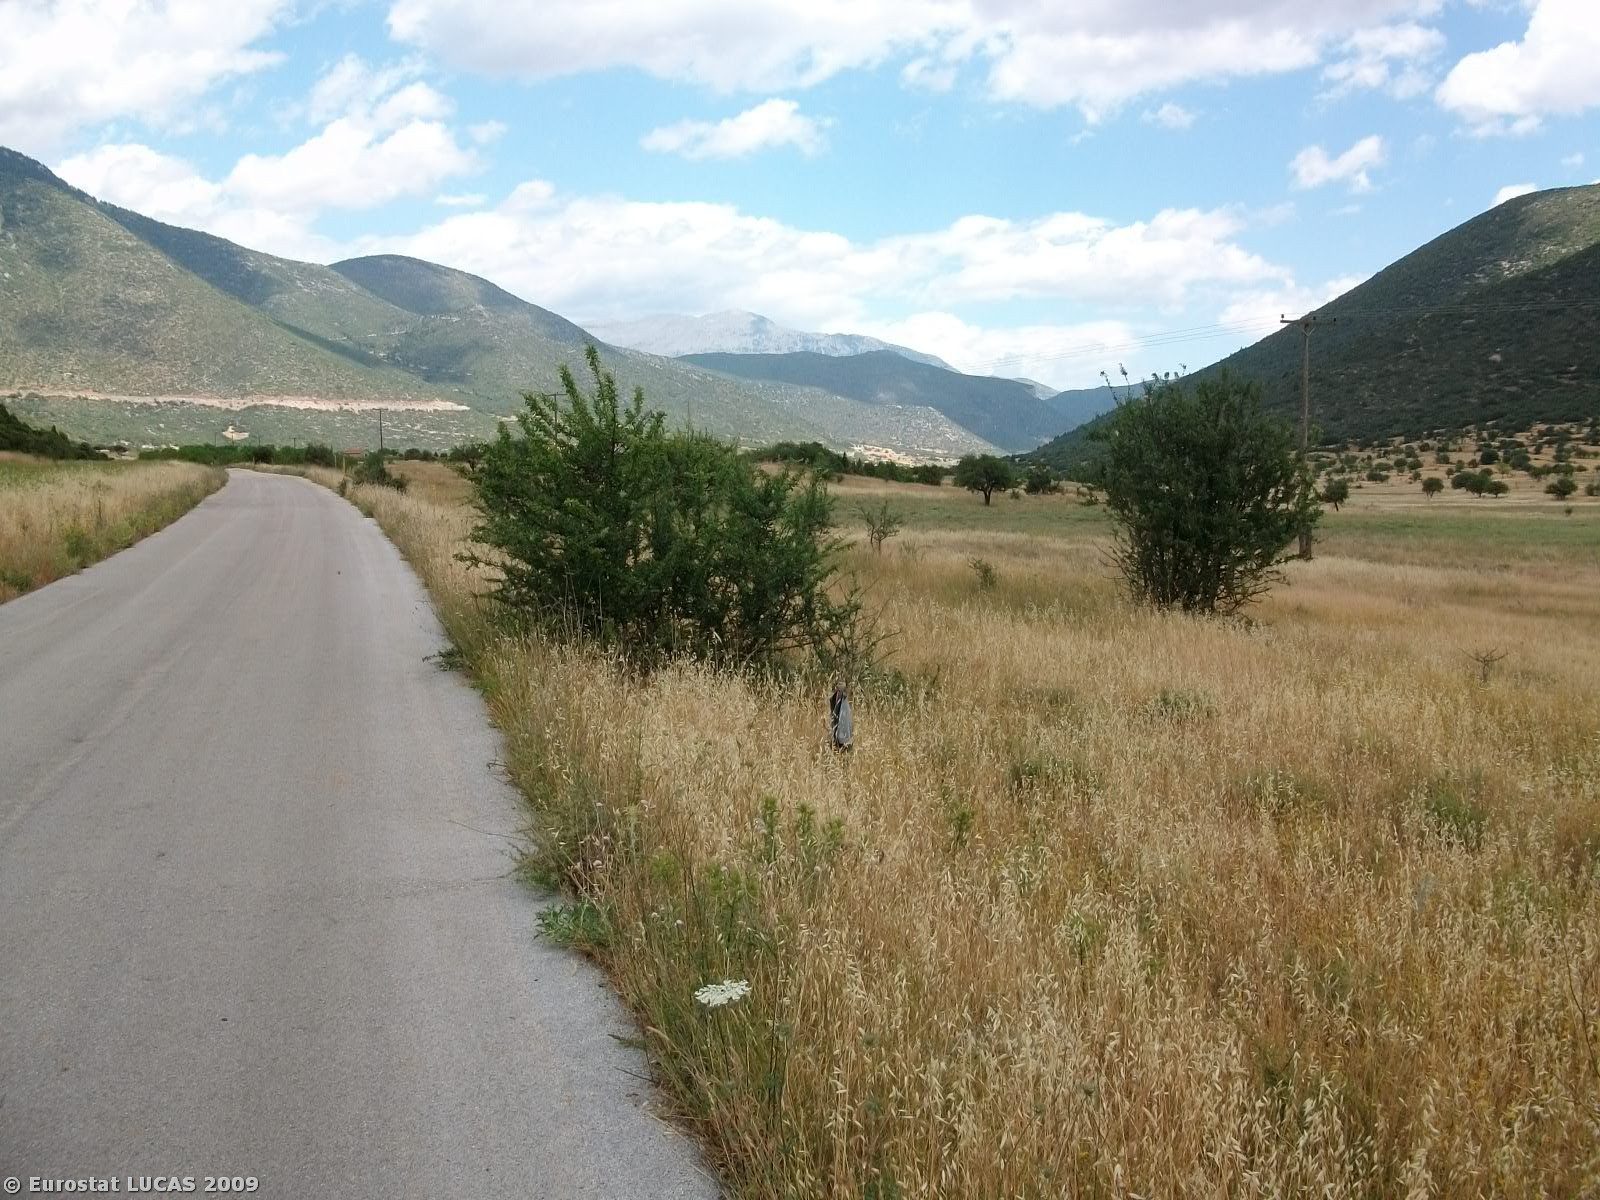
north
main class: Grassland
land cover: Grassland with sparse tree/shrub cover
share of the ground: > 75 %
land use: Unused
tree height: < 5 m
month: June
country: GR
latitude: 37.7848
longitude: 22.4680
